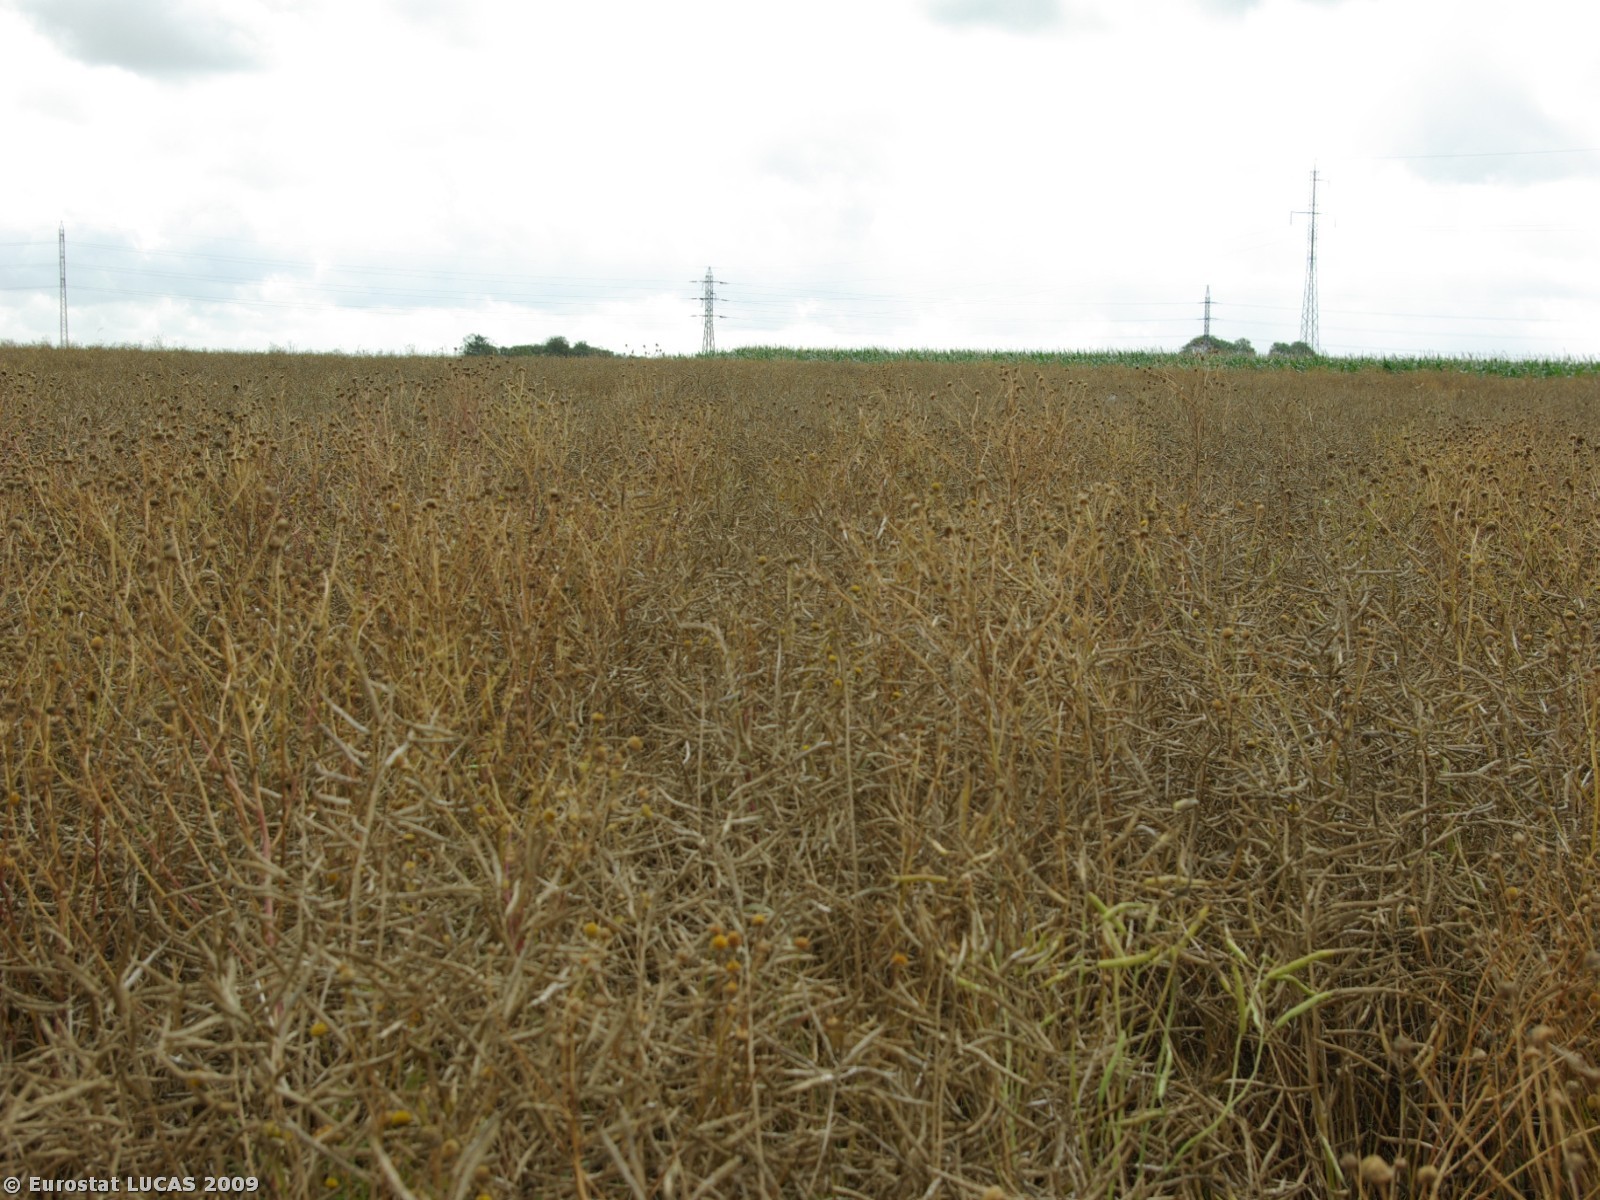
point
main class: Cropland
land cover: Rape and turnip rape
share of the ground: > 75 %
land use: Agriculture (excluding fallow land and kitchen gardens)
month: July
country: DK
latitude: 54.9606
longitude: 8.8920
